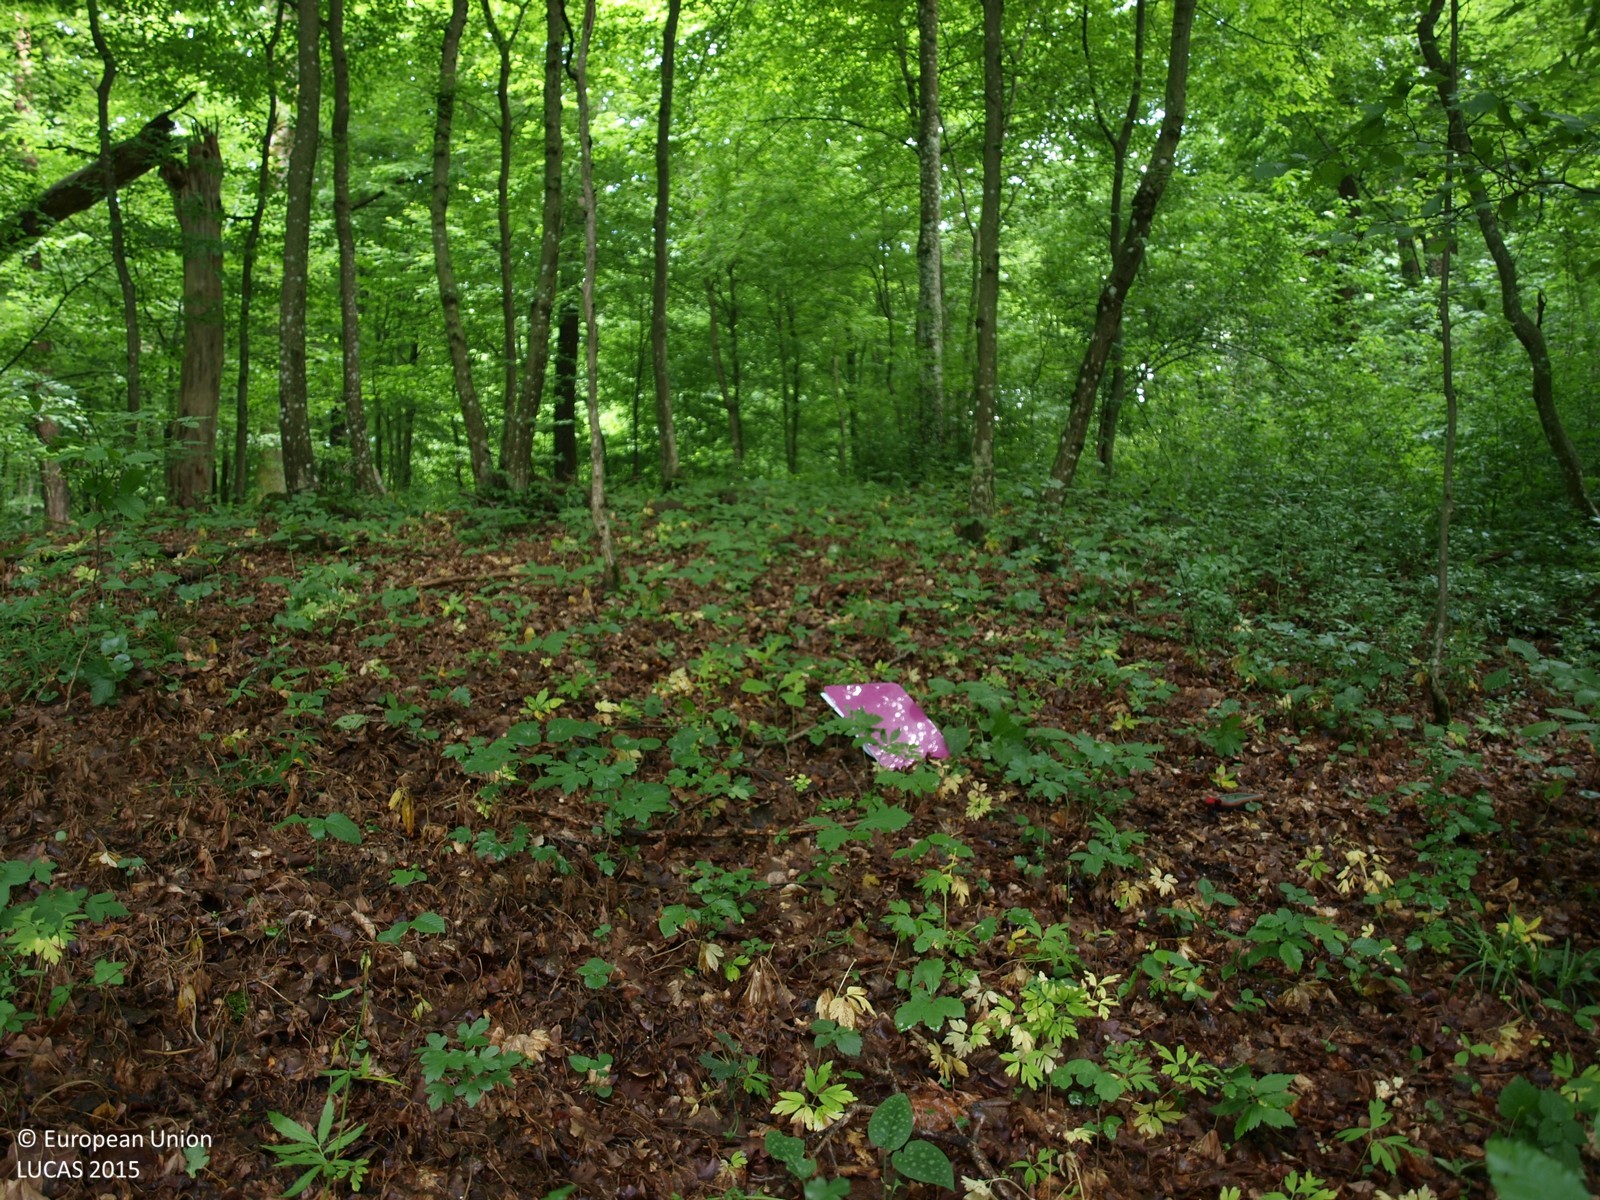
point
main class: Woodland
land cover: Broadleaved woodland
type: mesophytic deciduous forest
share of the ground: > 75 %
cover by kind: broadleaved forest trees 95 %, shrubs 5 %
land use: Forestry
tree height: > 5 m
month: May
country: HR
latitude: 46.1352
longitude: 16.1995
